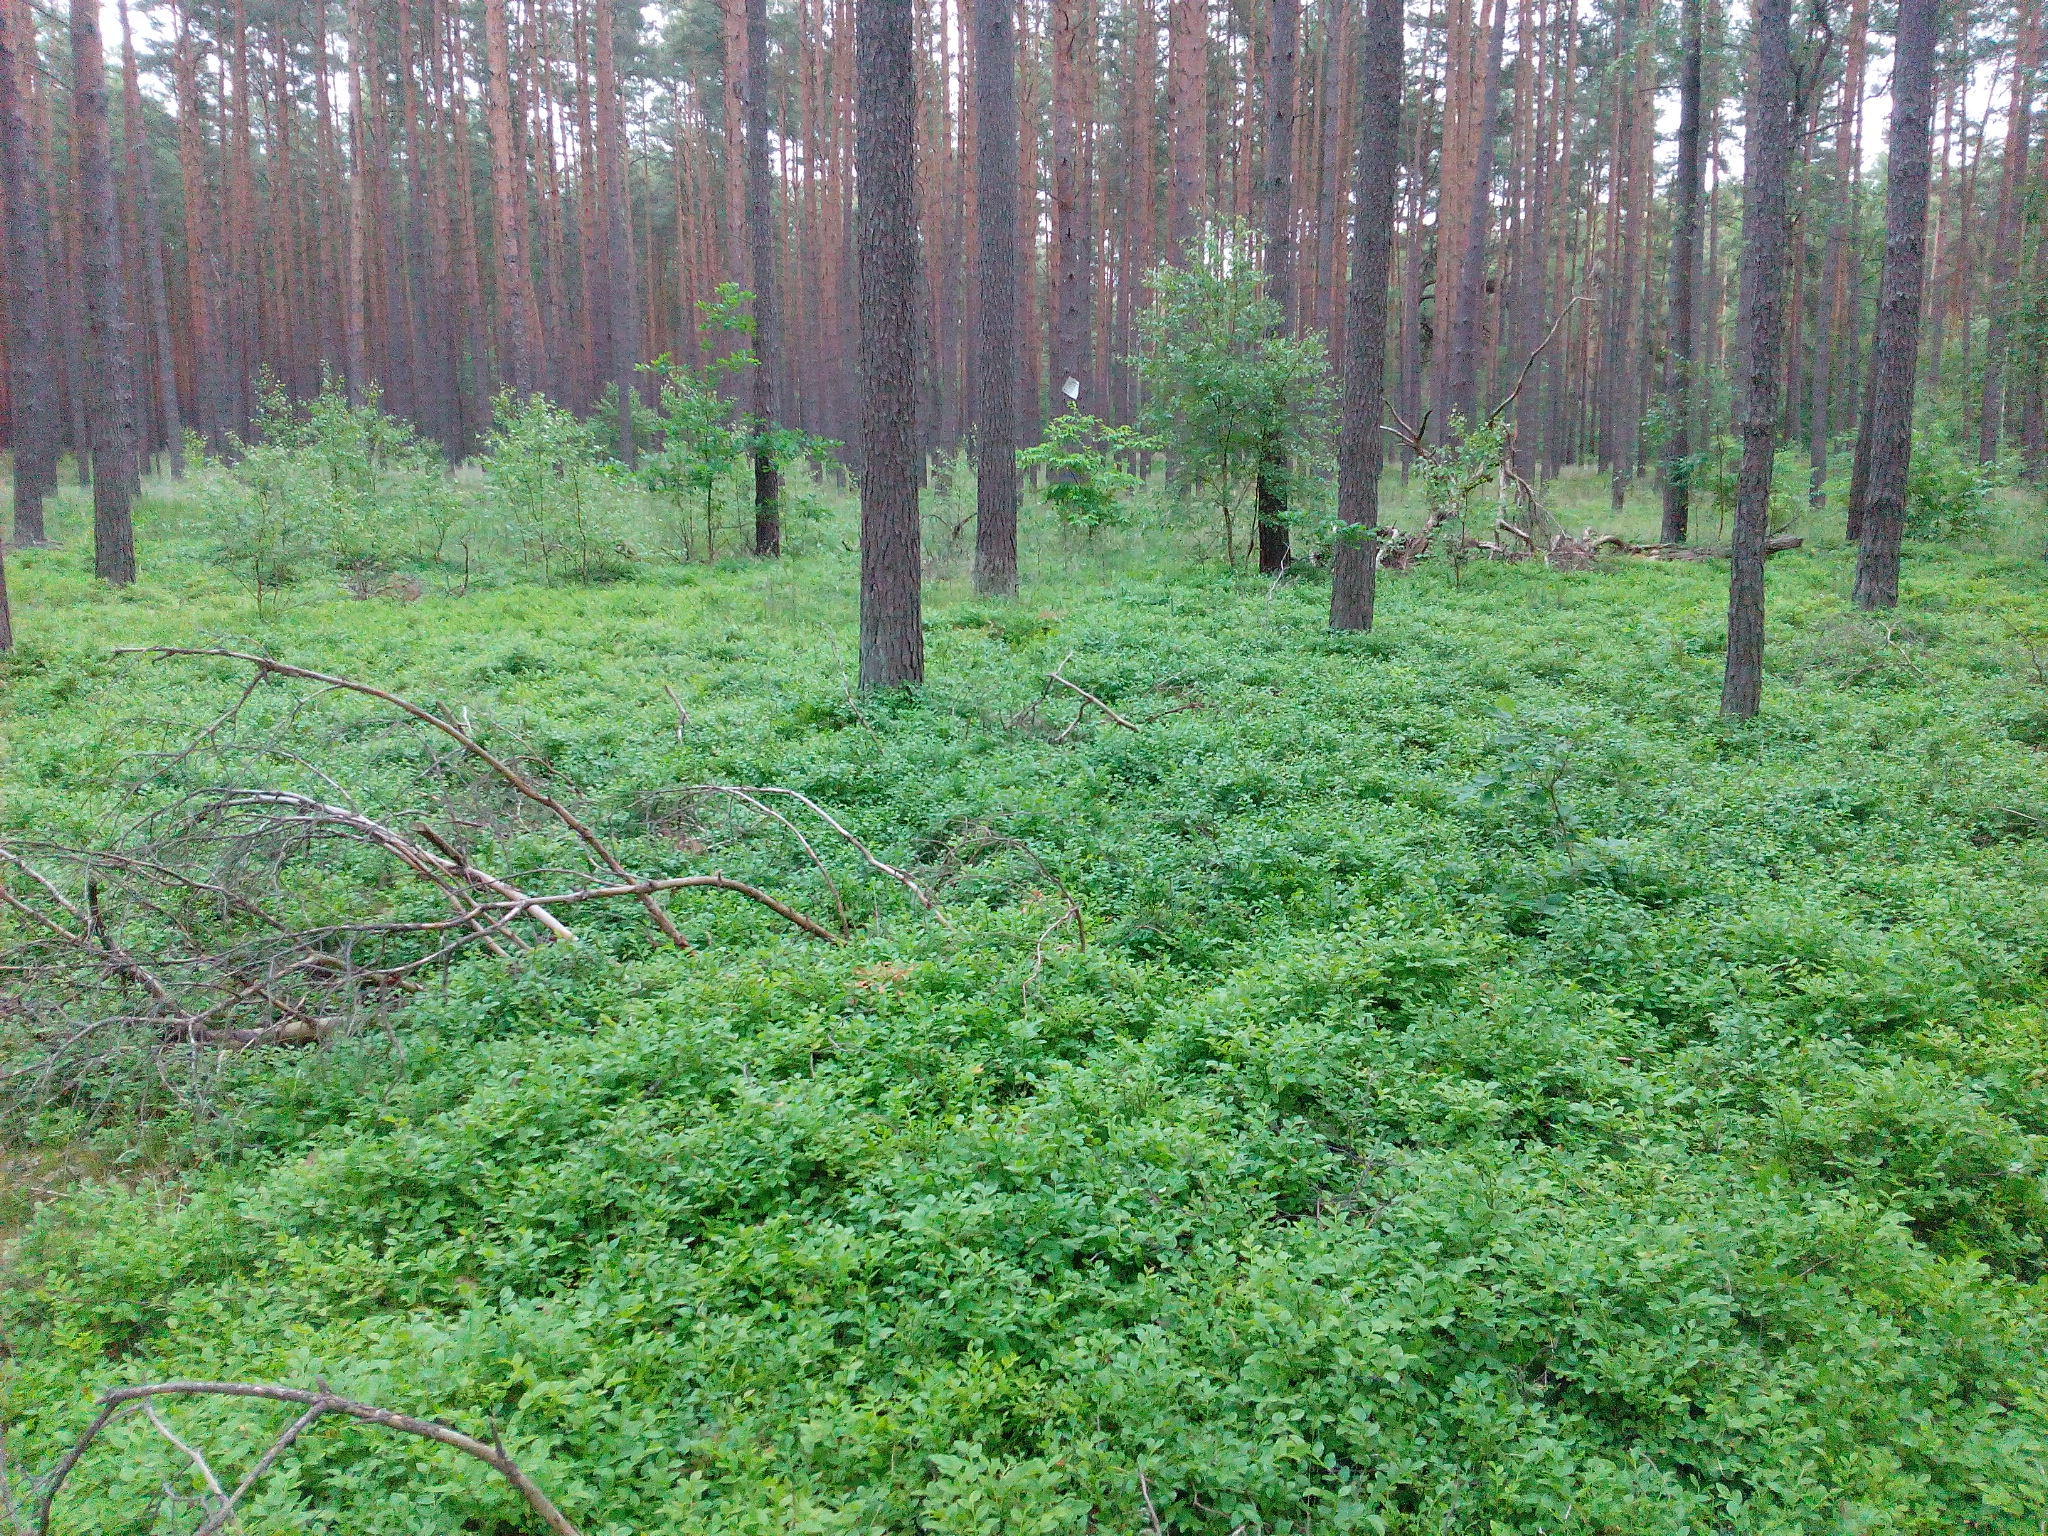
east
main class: Woodland
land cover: Pine dominated coniferous woodland
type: hemiboreal forest and nemoral coniferous forest and mixed broadleaved-coniferous forest
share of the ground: 50 - 75 %
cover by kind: coniferous forest trees 55 %, herbaceous plants 40 %, lichens and mosses 5 %
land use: Forestry
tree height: > 5 m
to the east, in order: Pine dominated coniferous woodland; Tracks; Pine dominated coniferous woodland; Ditches and canals; Pine dominated coniferous woodland
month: June
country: DE
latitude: 53.1981
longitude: 13.1882
